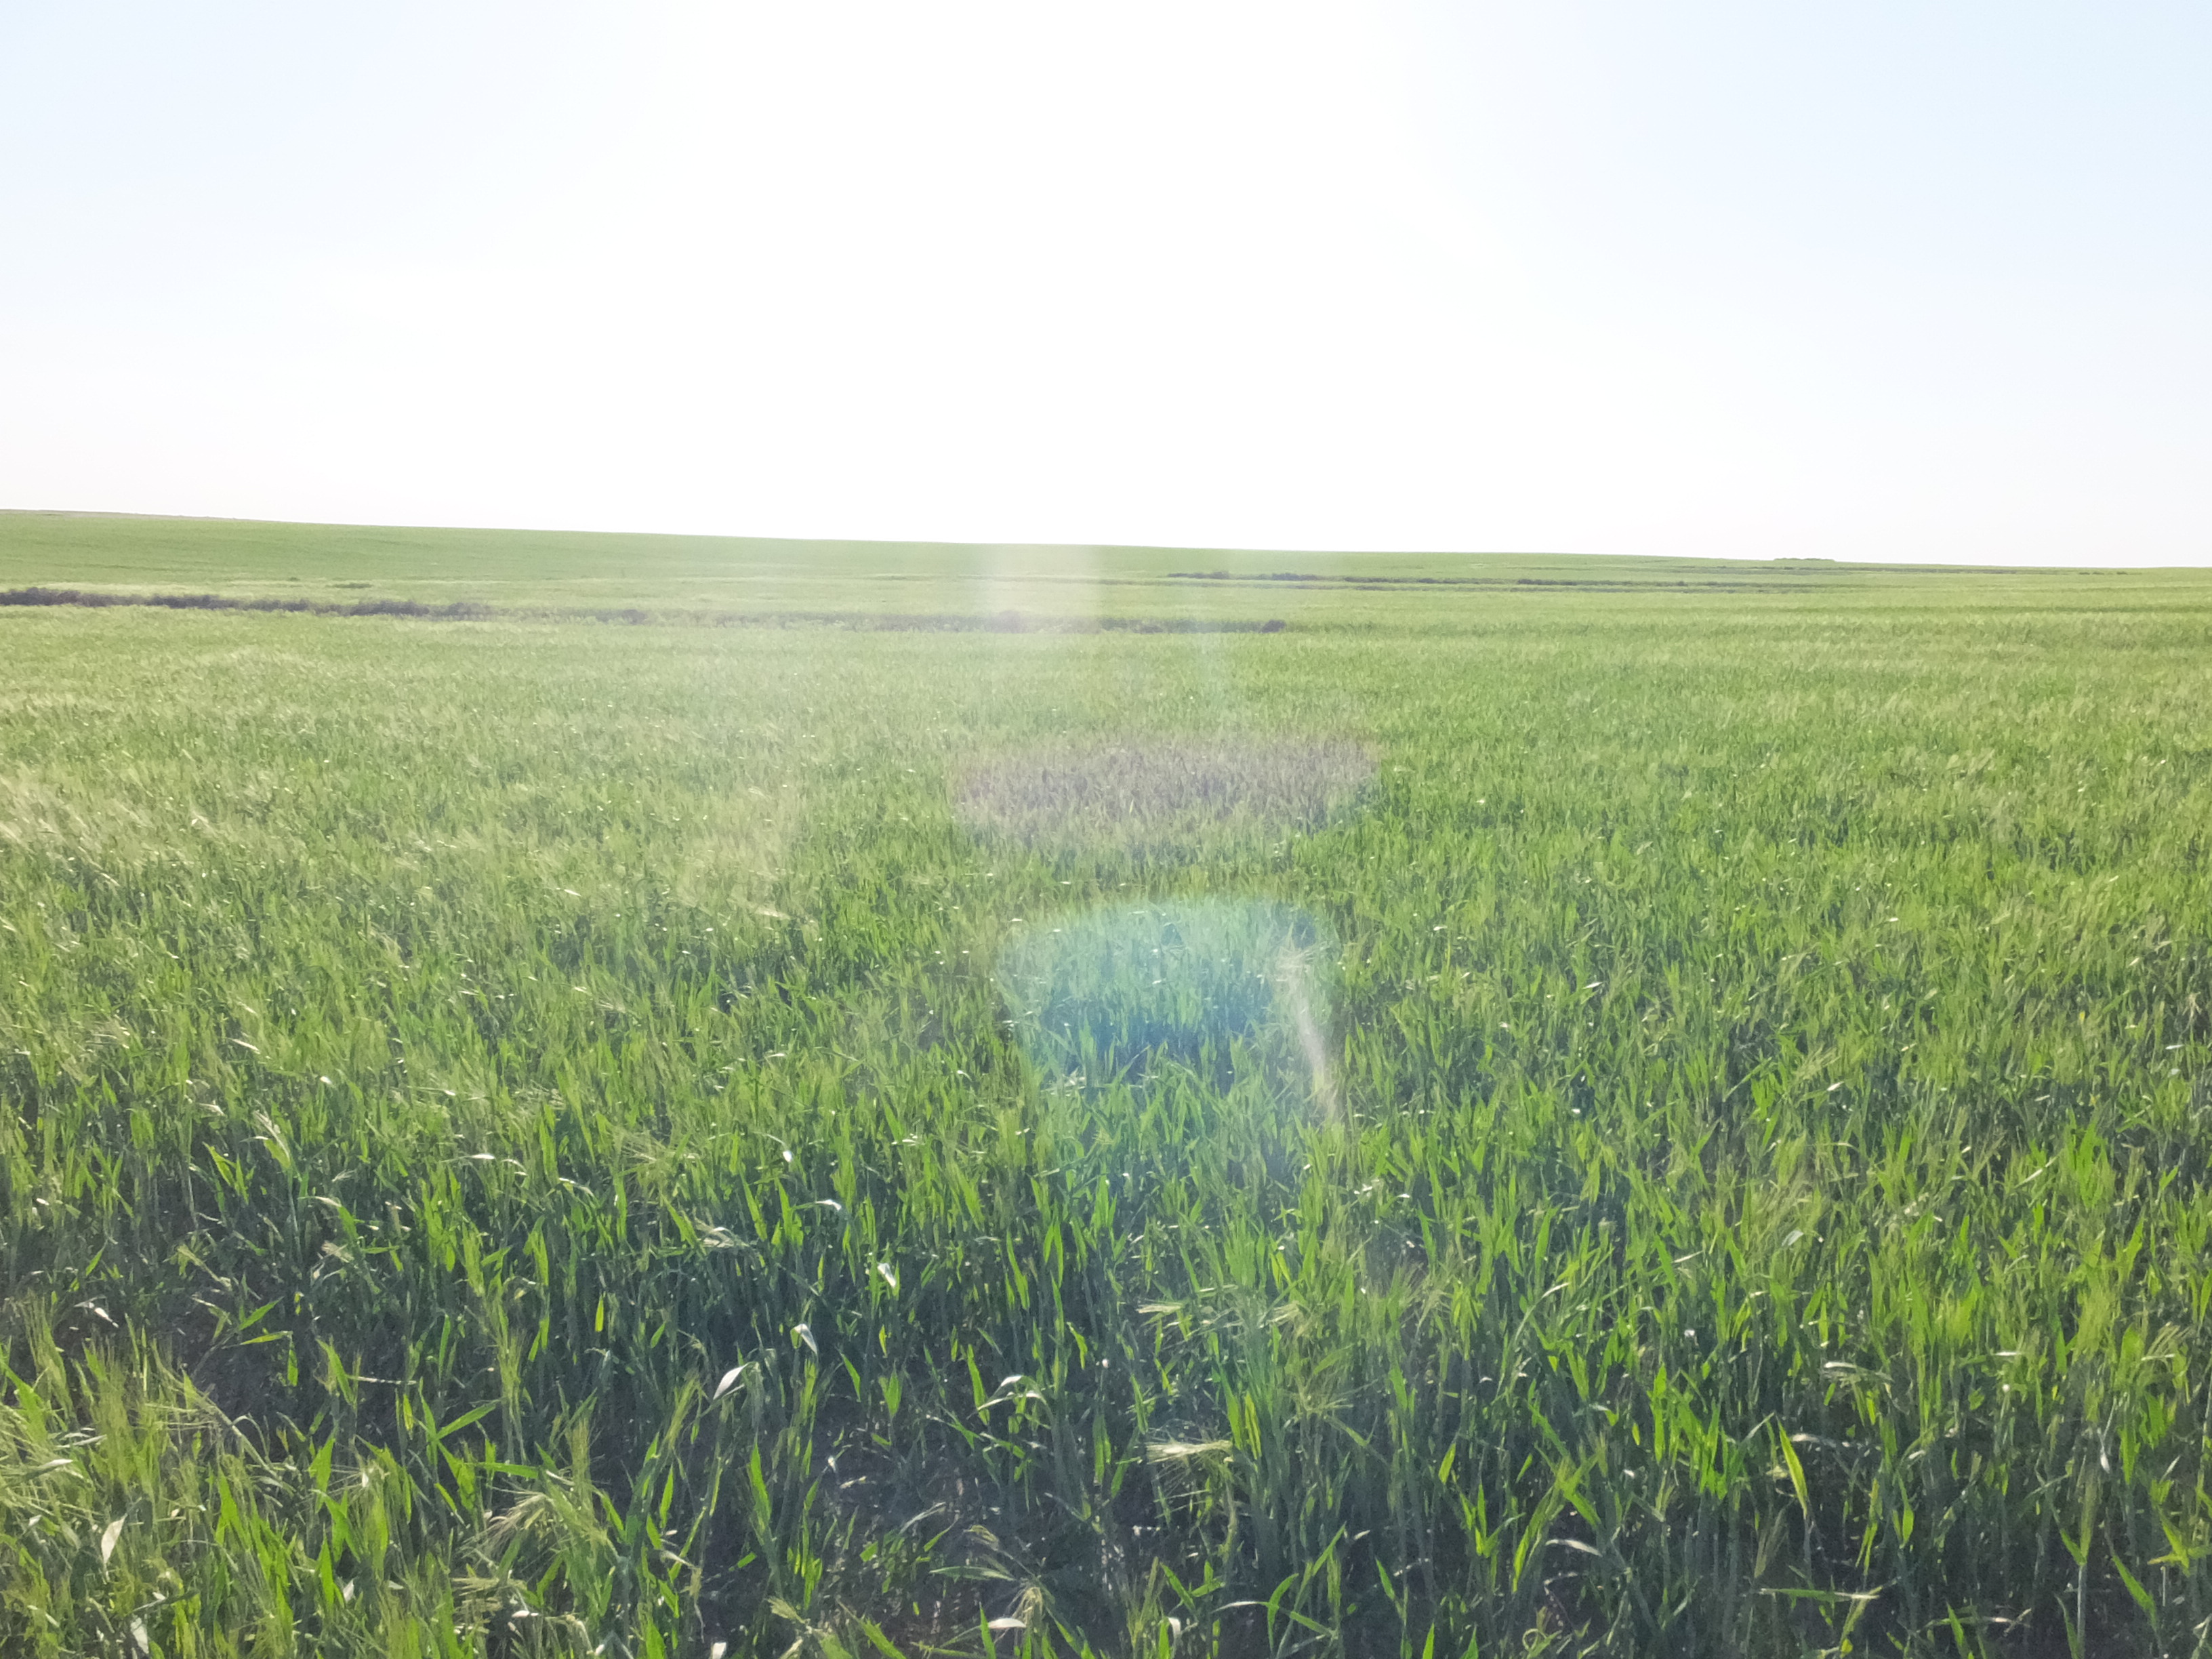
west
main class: Cropland
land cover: Durum wheat
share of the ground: > 75 %
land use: Agriculture (excluding fallow land and kitchen gardens)
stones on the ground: < 10 %
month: April
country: ES
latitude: 41.5462
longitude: -0.2904
